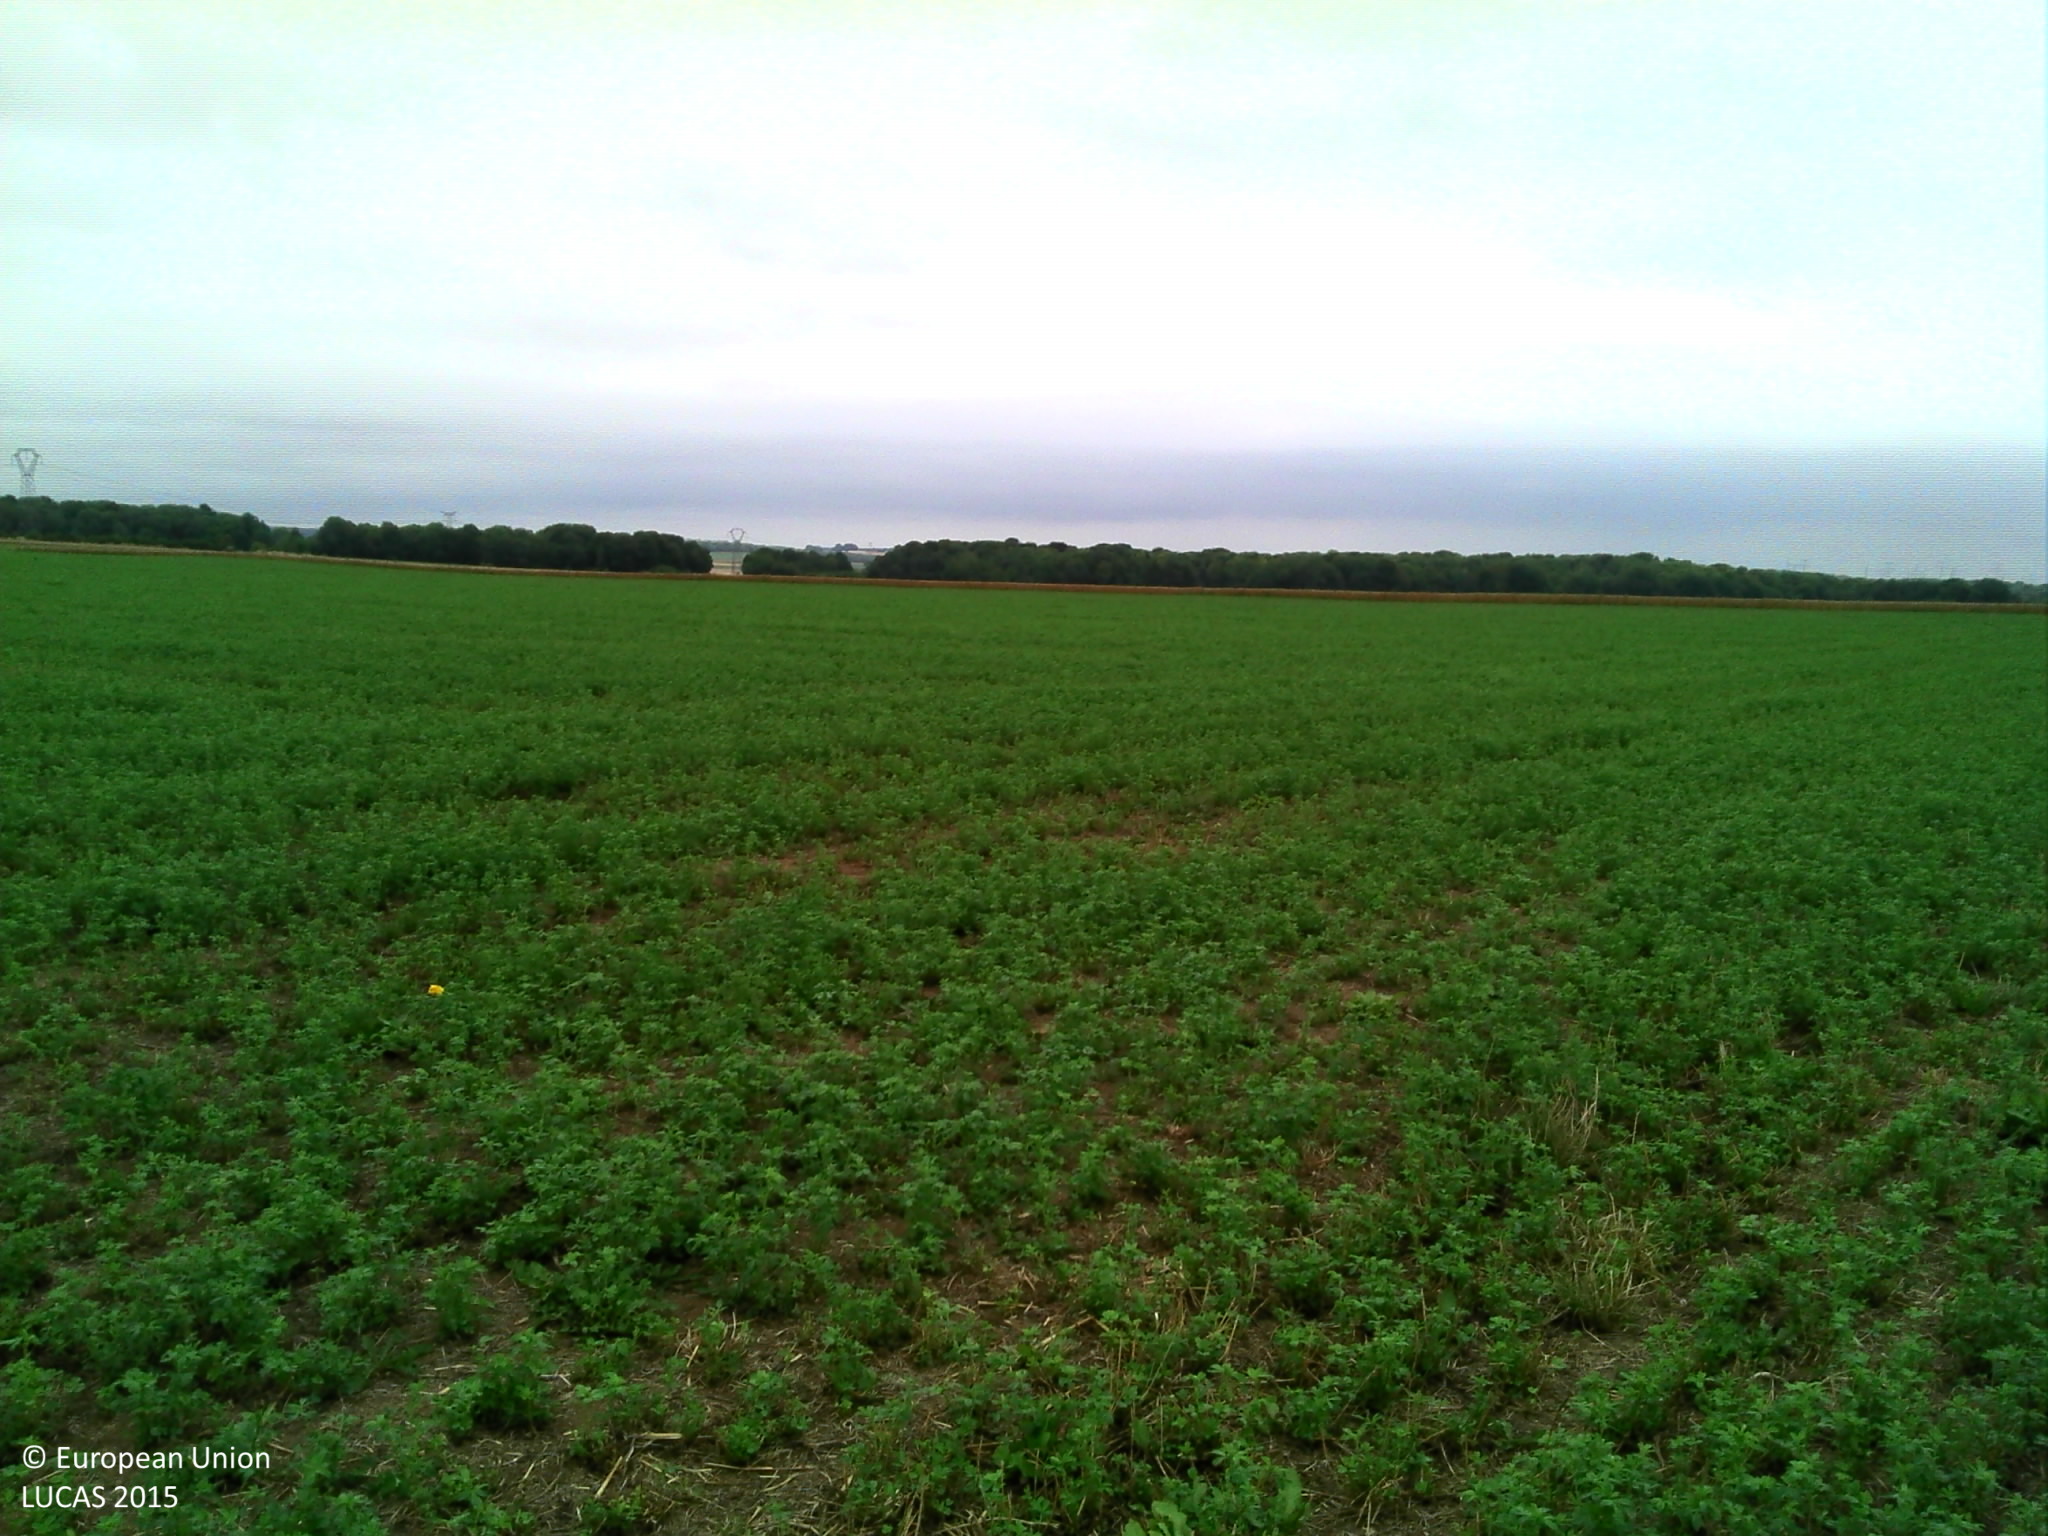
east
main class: Cropland
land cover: Lucerne
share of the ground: > 75 %
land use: Agriculture (excluding fallow land and kitchen gardens)
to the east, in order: Lucerne; Common wheat
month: July
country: FR
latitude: 49.9685
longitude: 2.1642
